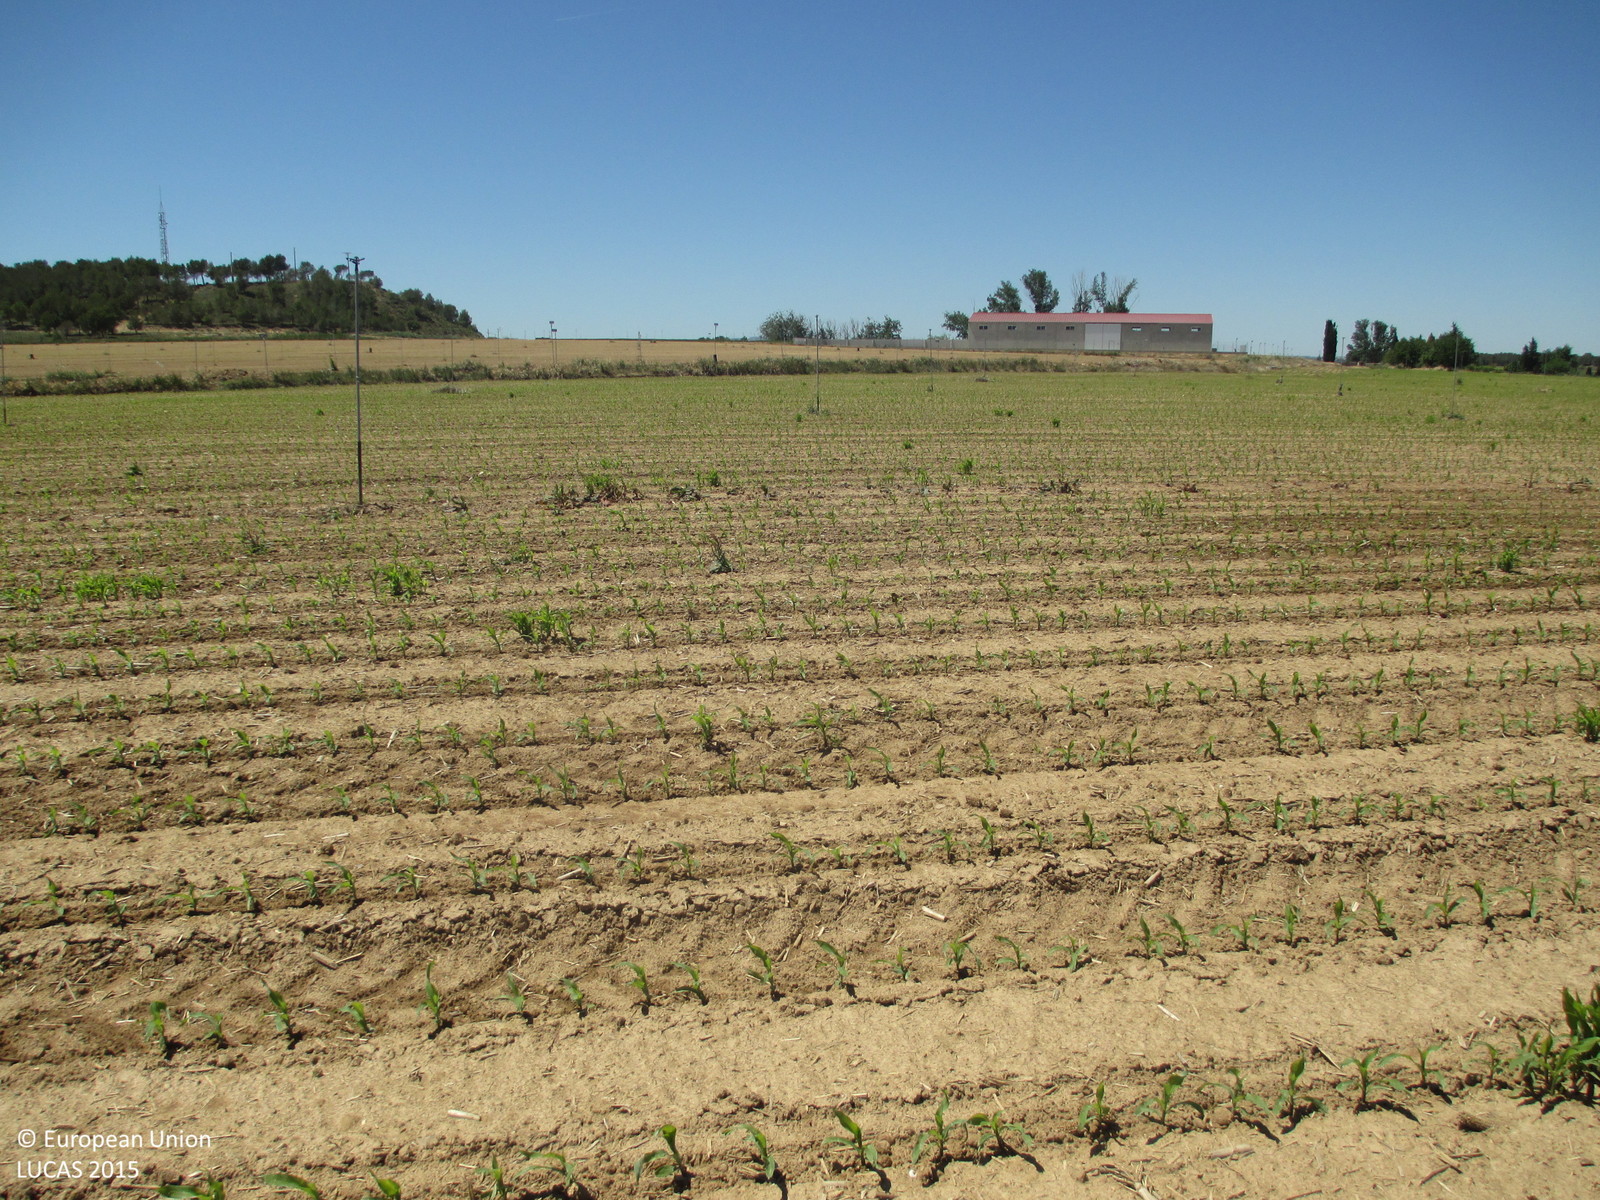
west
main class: Cropland
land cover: Maize
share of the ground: < 10 %
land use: Agriculture (excluding fallow land and kitchen gardens)
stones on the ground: < 10 %
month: May
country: ES
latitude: 41.9089
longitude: -0.3033
